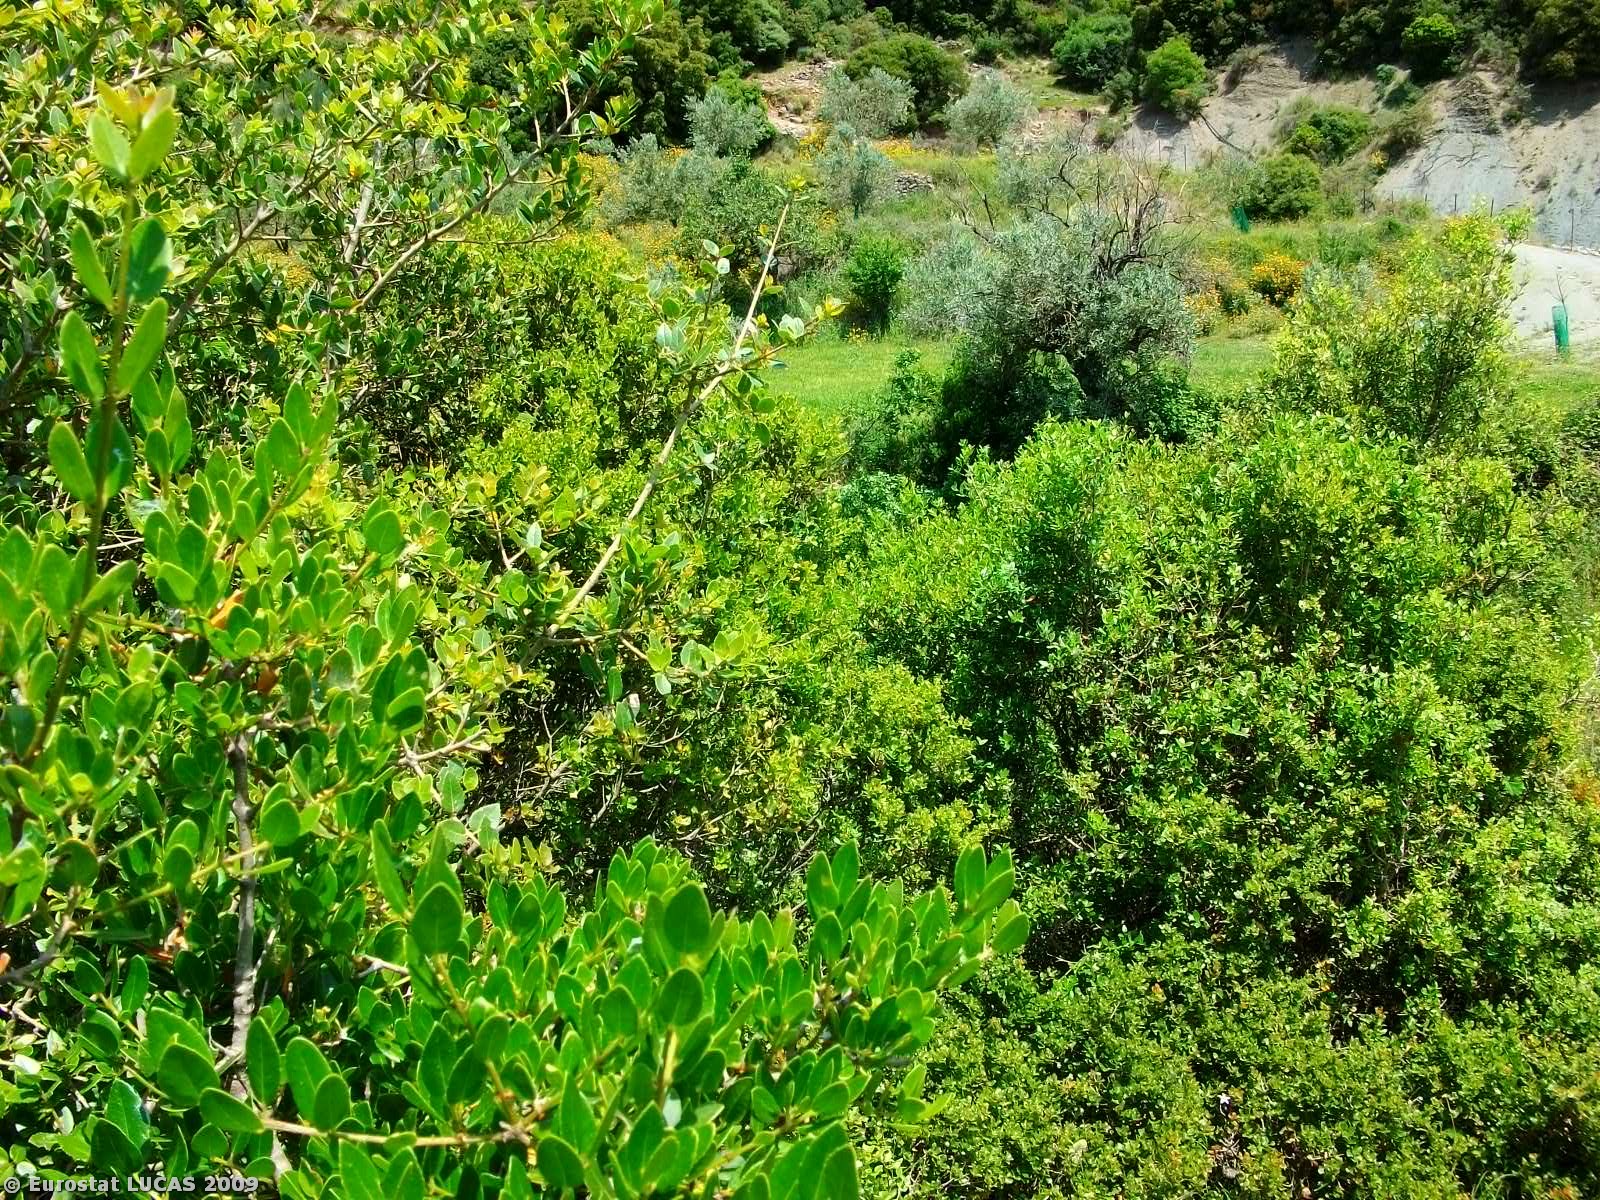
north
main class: Shrubland
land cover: Shrubland with sparse tree cover
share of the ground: > 75 %
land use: Agriculture (excluding fallow land and kitchen gardens)
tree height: > 5 m
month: May
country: GR
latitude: 38.6726
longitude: 21.5226
